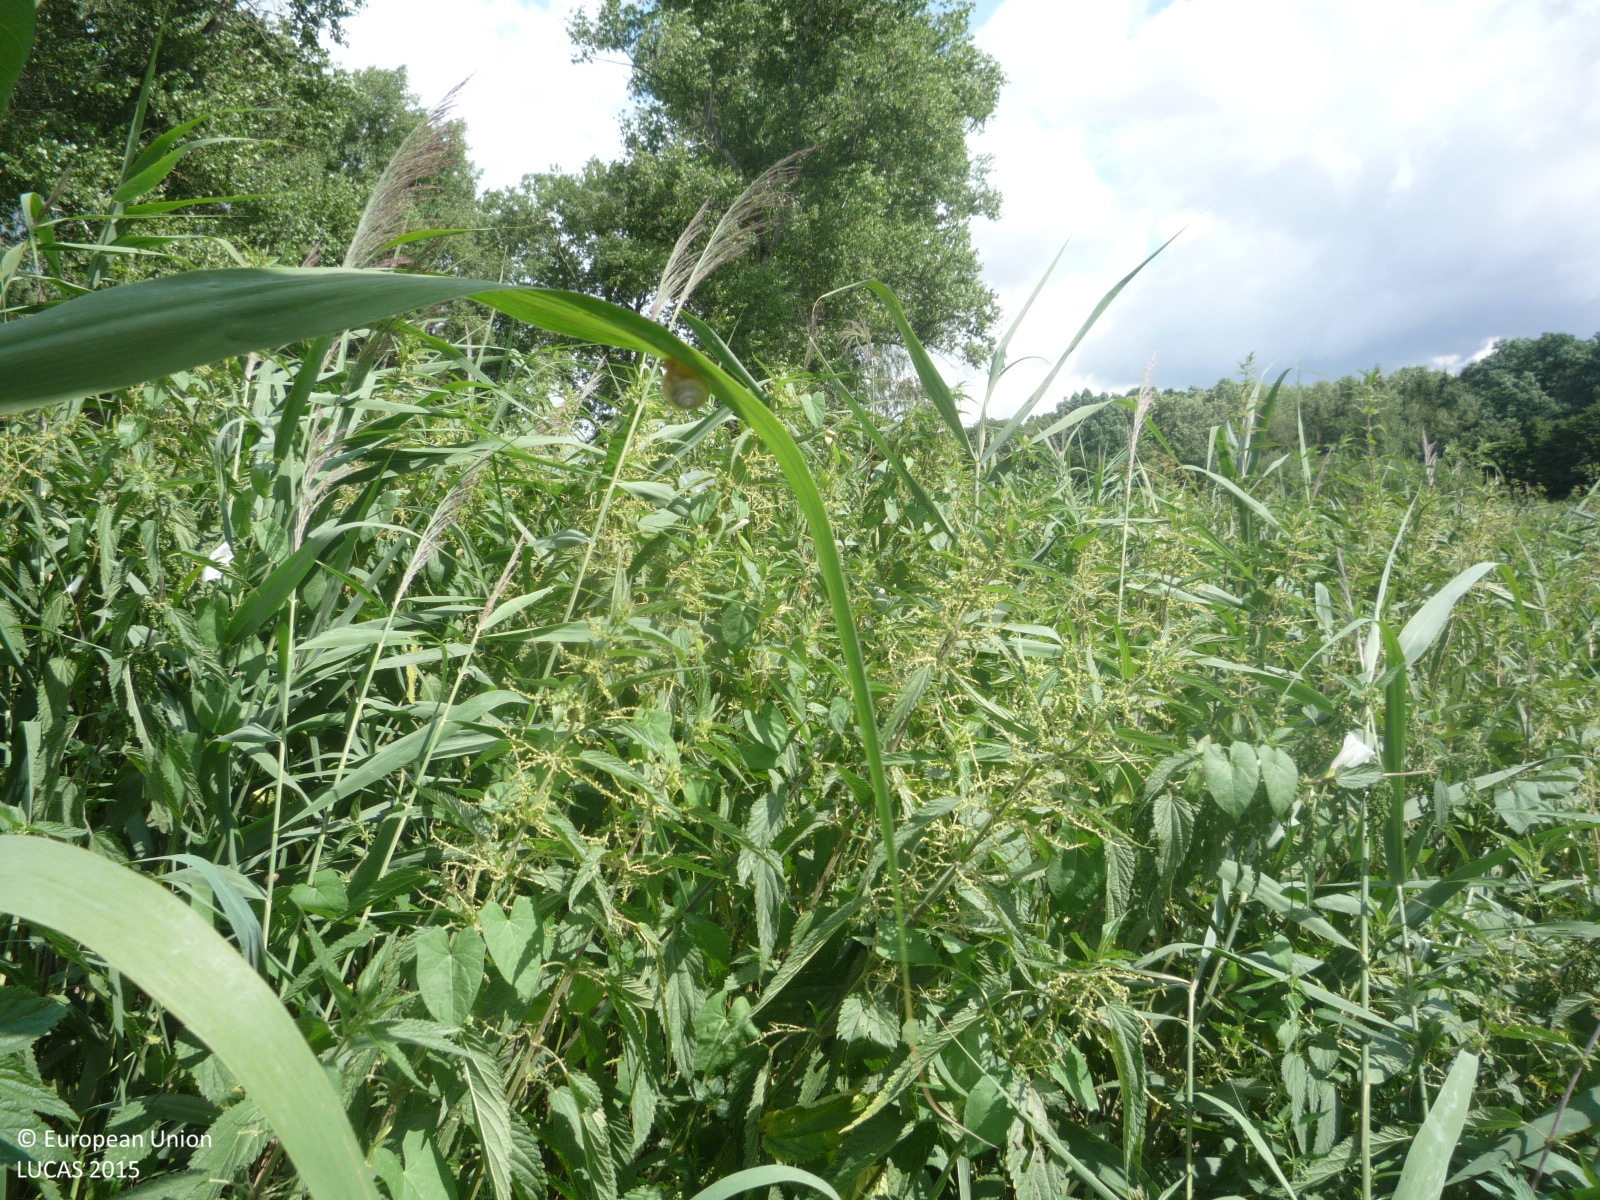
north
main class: Grassland
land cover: Spontaneously vegetated surfaces
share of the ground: > 75 %
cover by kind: herbaceous plants 100 %
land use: Semi-natural and natural areas not in use
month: July
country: CZ
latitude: 50.3365
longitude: 15.1876
